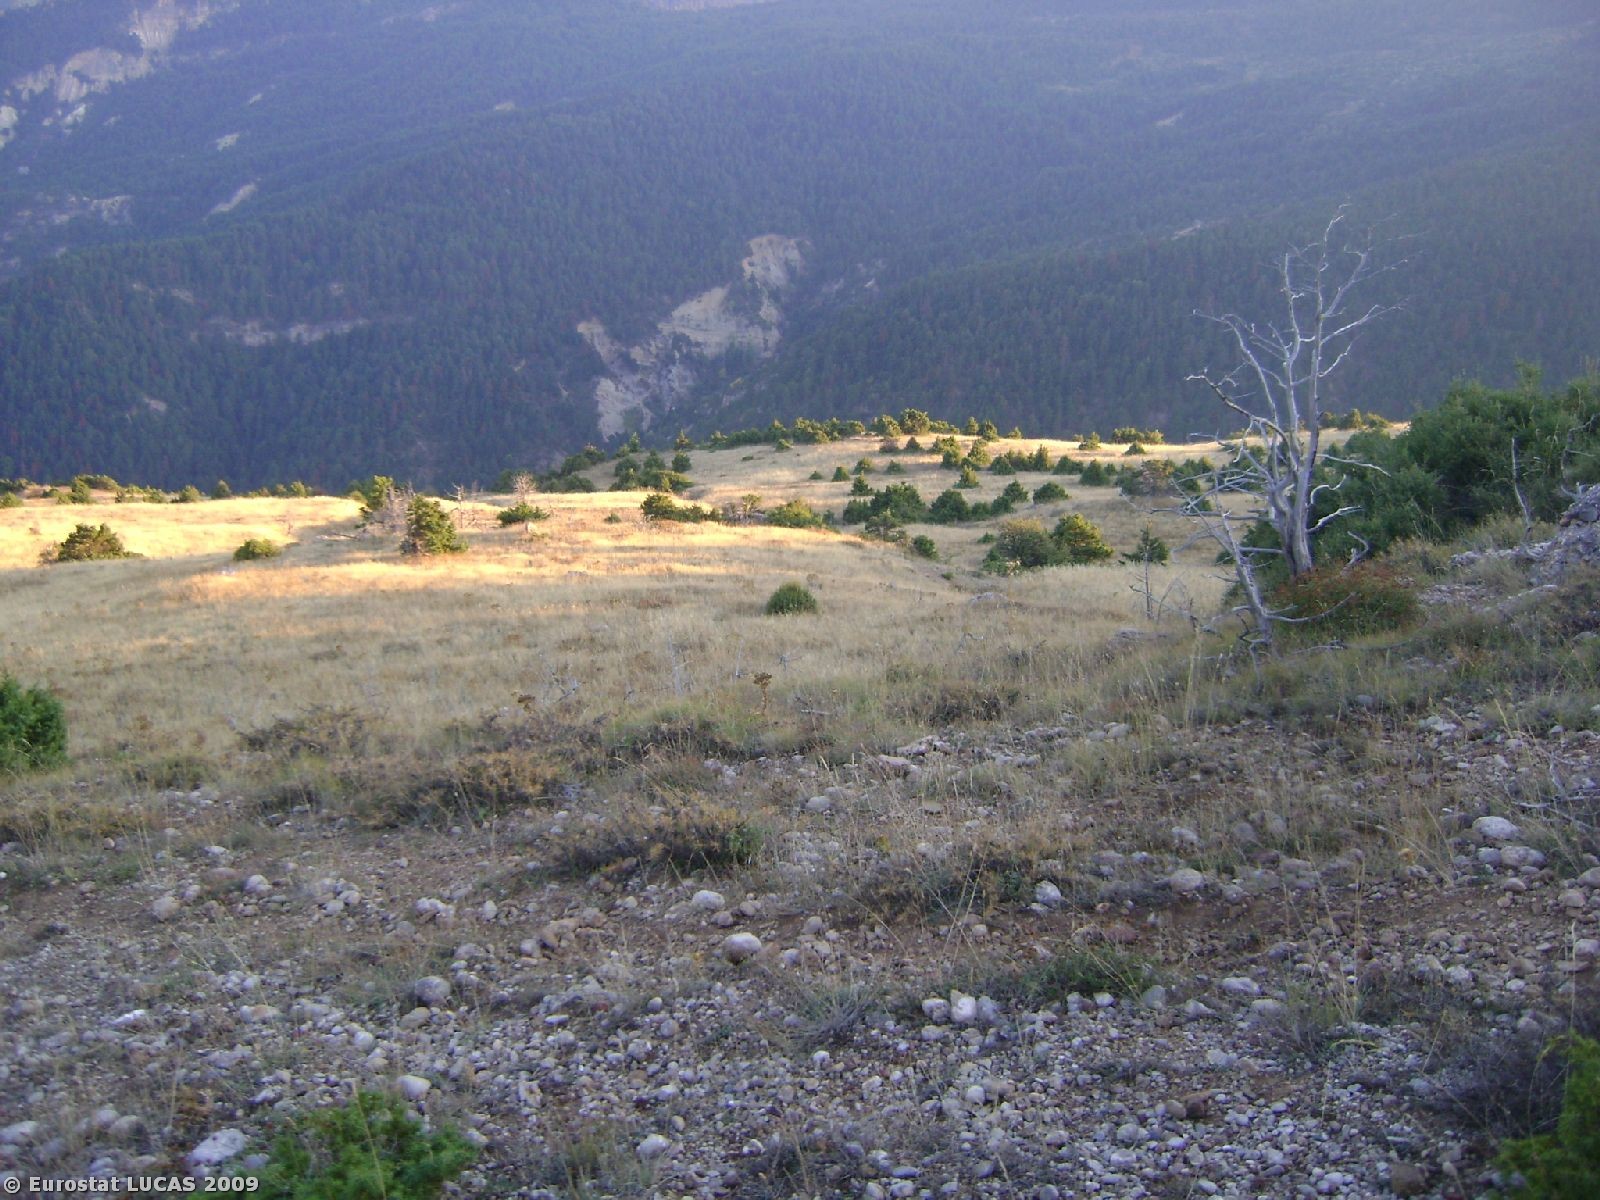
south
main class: Woodland
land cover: Broadleaved woodland
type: thermophilous deciduous forest
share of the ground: > 75 %
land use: Forestry
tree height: > 5 m
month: October
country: GR
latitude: 38.0437
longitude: 22.3091
